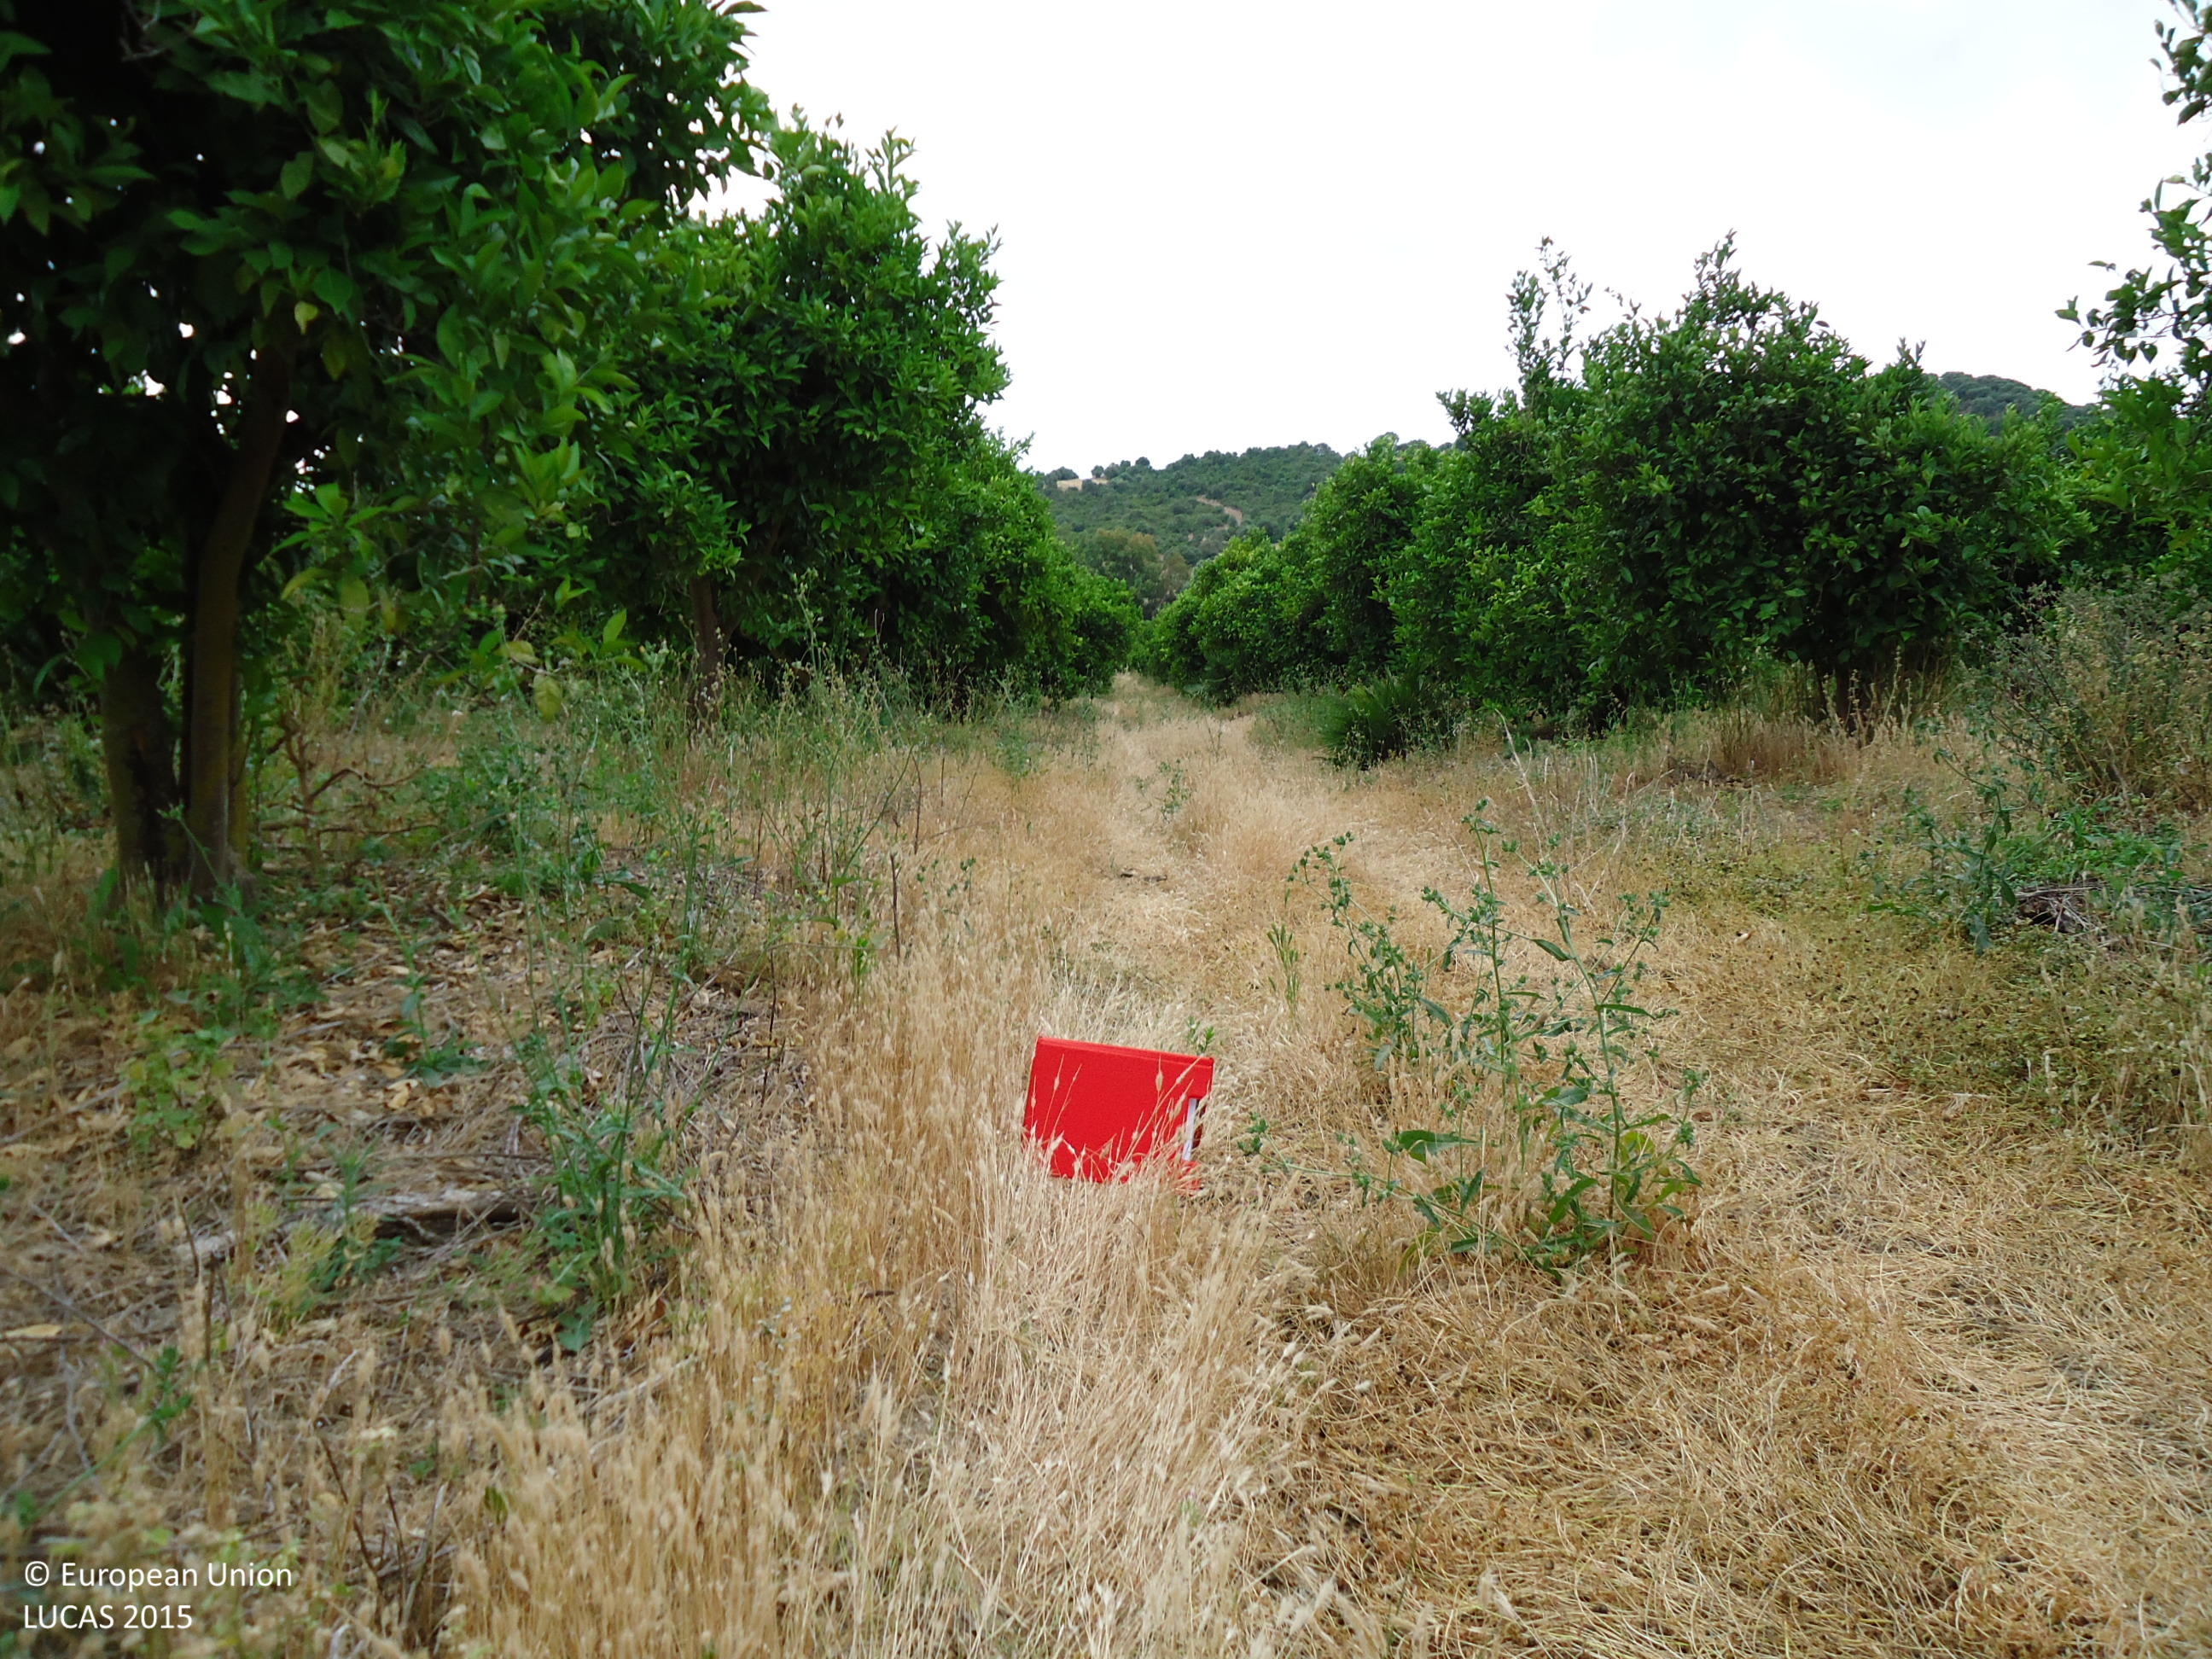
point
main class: Cropland
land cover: Oranges
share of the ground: > 75 %
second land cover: Grassland without tree/shrub cover
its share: > 75 %
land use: Agriculture (excluding fallow land and kitchen gardens)
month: June
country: ES
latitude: 36.4013
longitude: -5.3490
